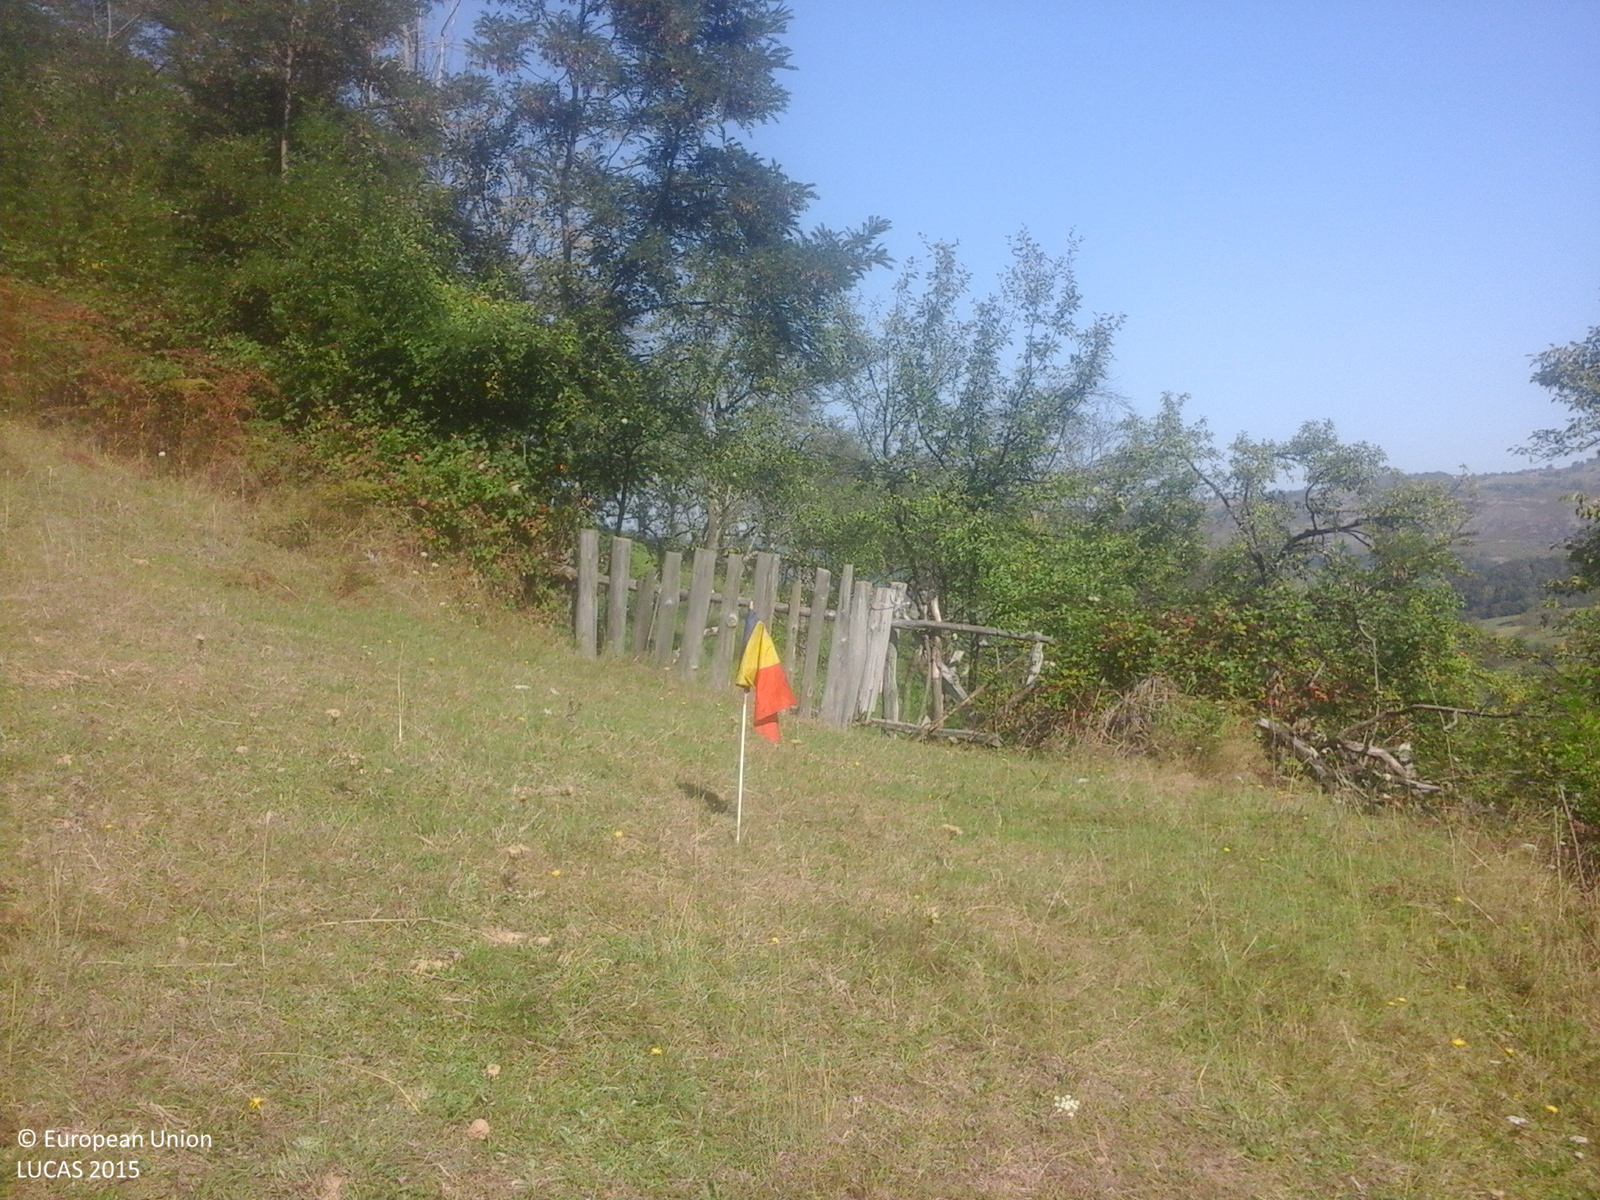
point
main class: Grassland
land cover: Grassland without tree/shrub cover
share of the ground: > 75 %
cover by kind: herbaceous plants 100 %
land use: Agriculture (excluding fallow land and kitchen gardens)
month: September
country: RO
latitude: 46.8121
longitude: 22.3836
